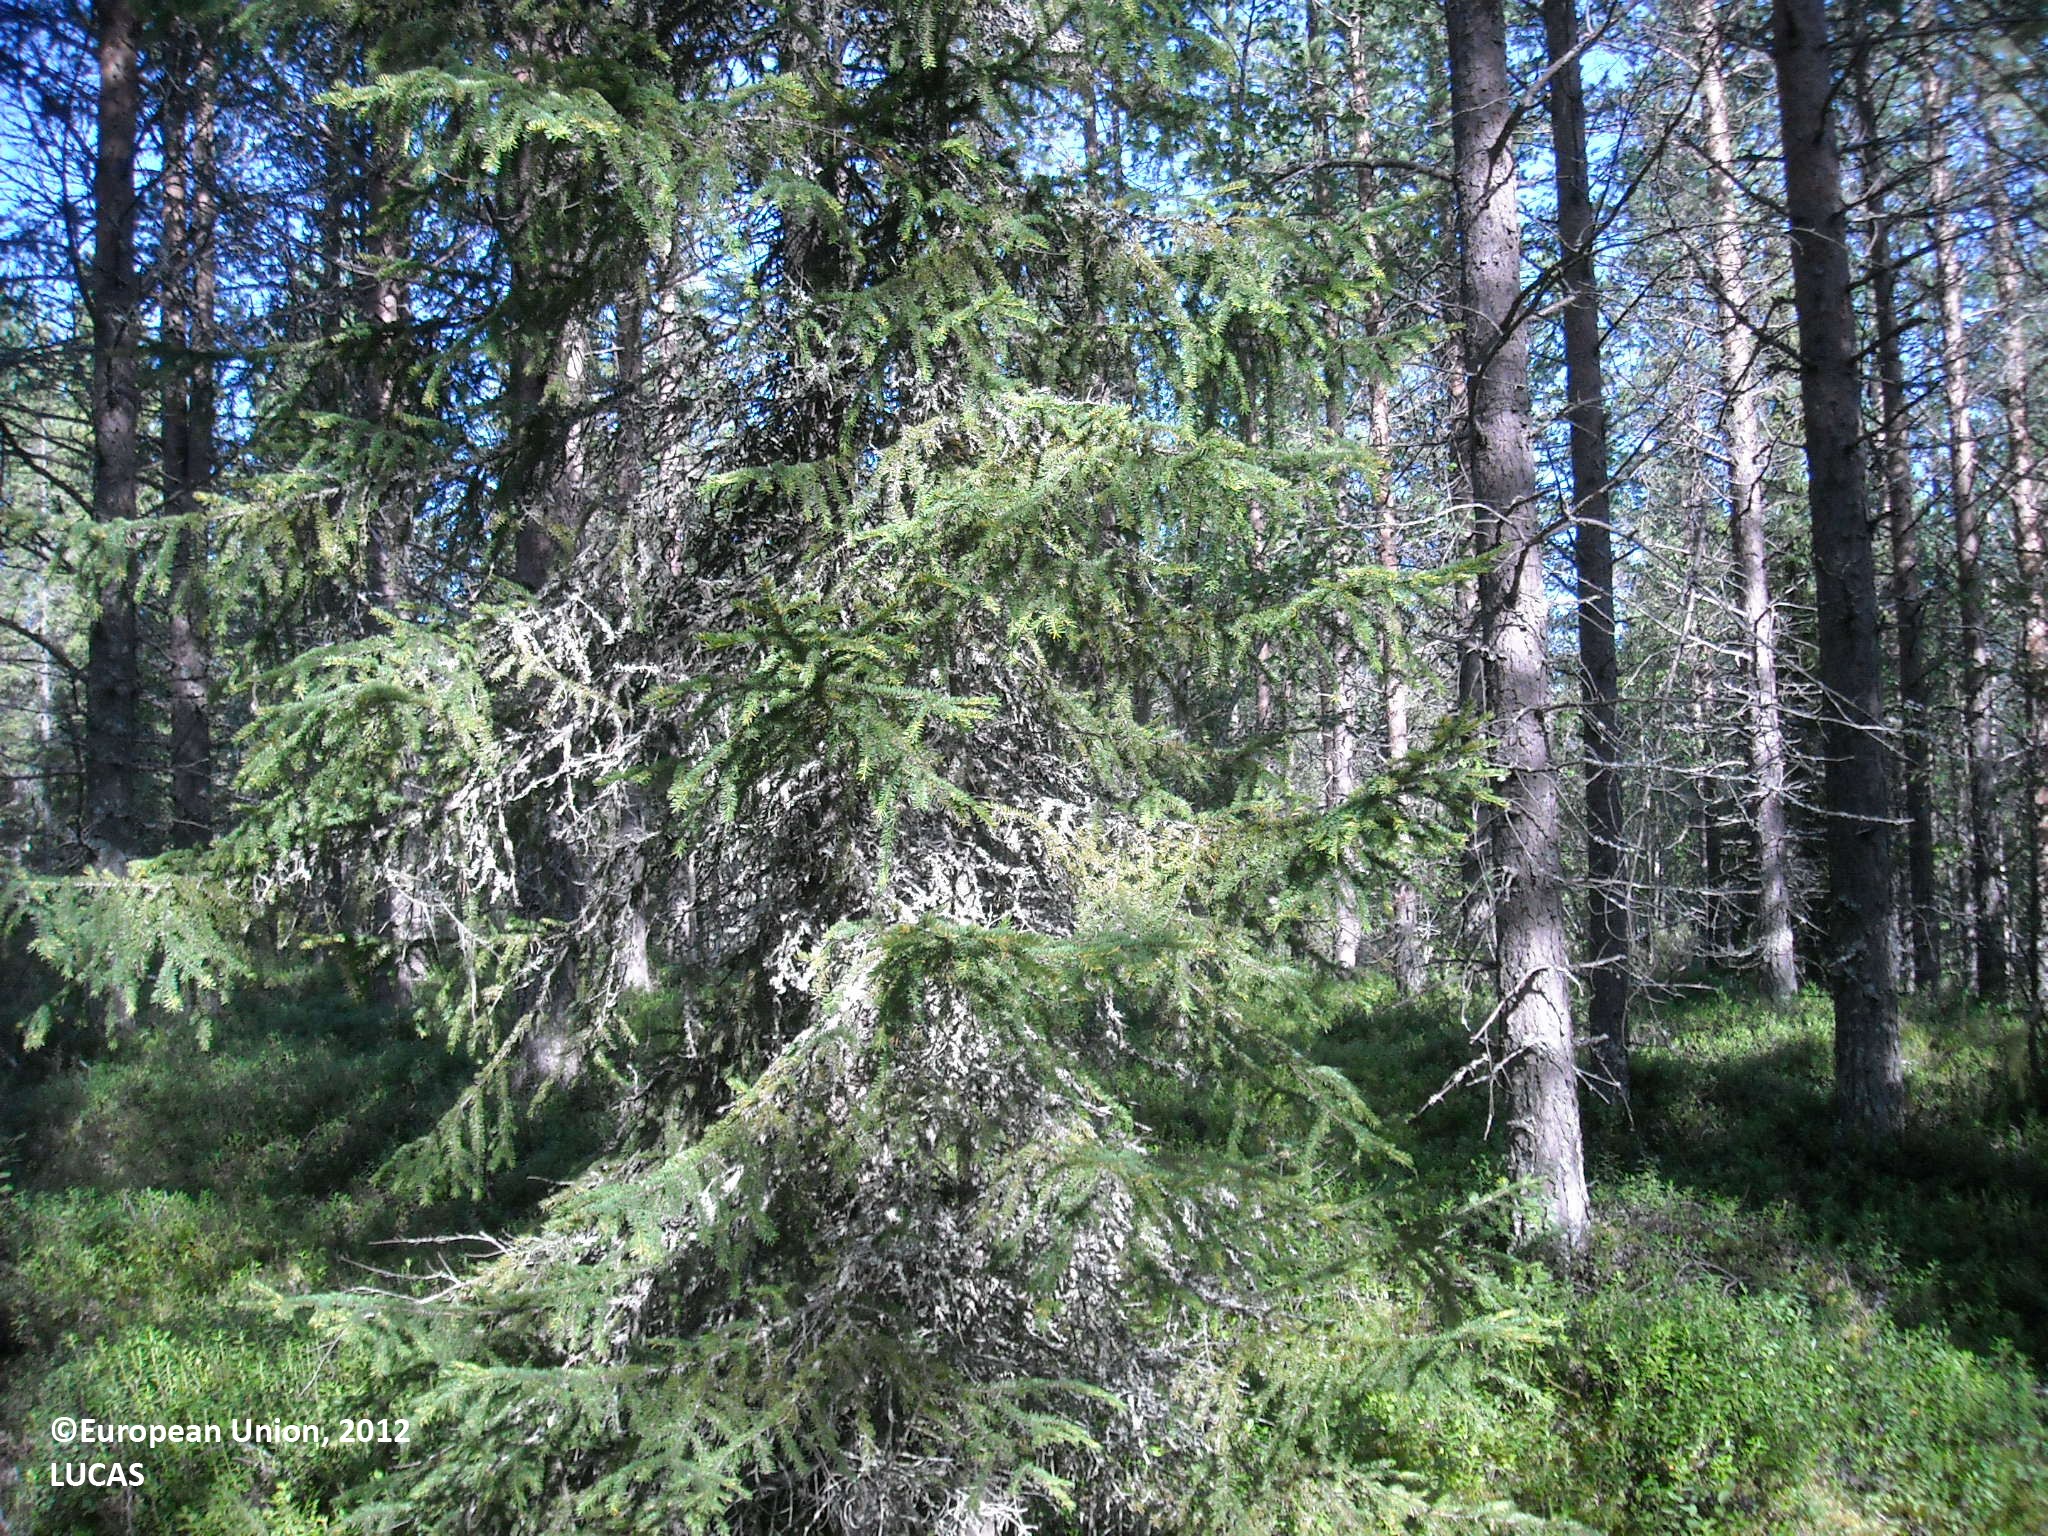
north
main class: Woodland
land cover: Other coniferous woodland
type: boreal forest
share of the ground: 50 - 75 %
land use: Forestry
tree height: > 5 m
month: August
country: FI
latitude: 65.1210
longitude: 27.7163
